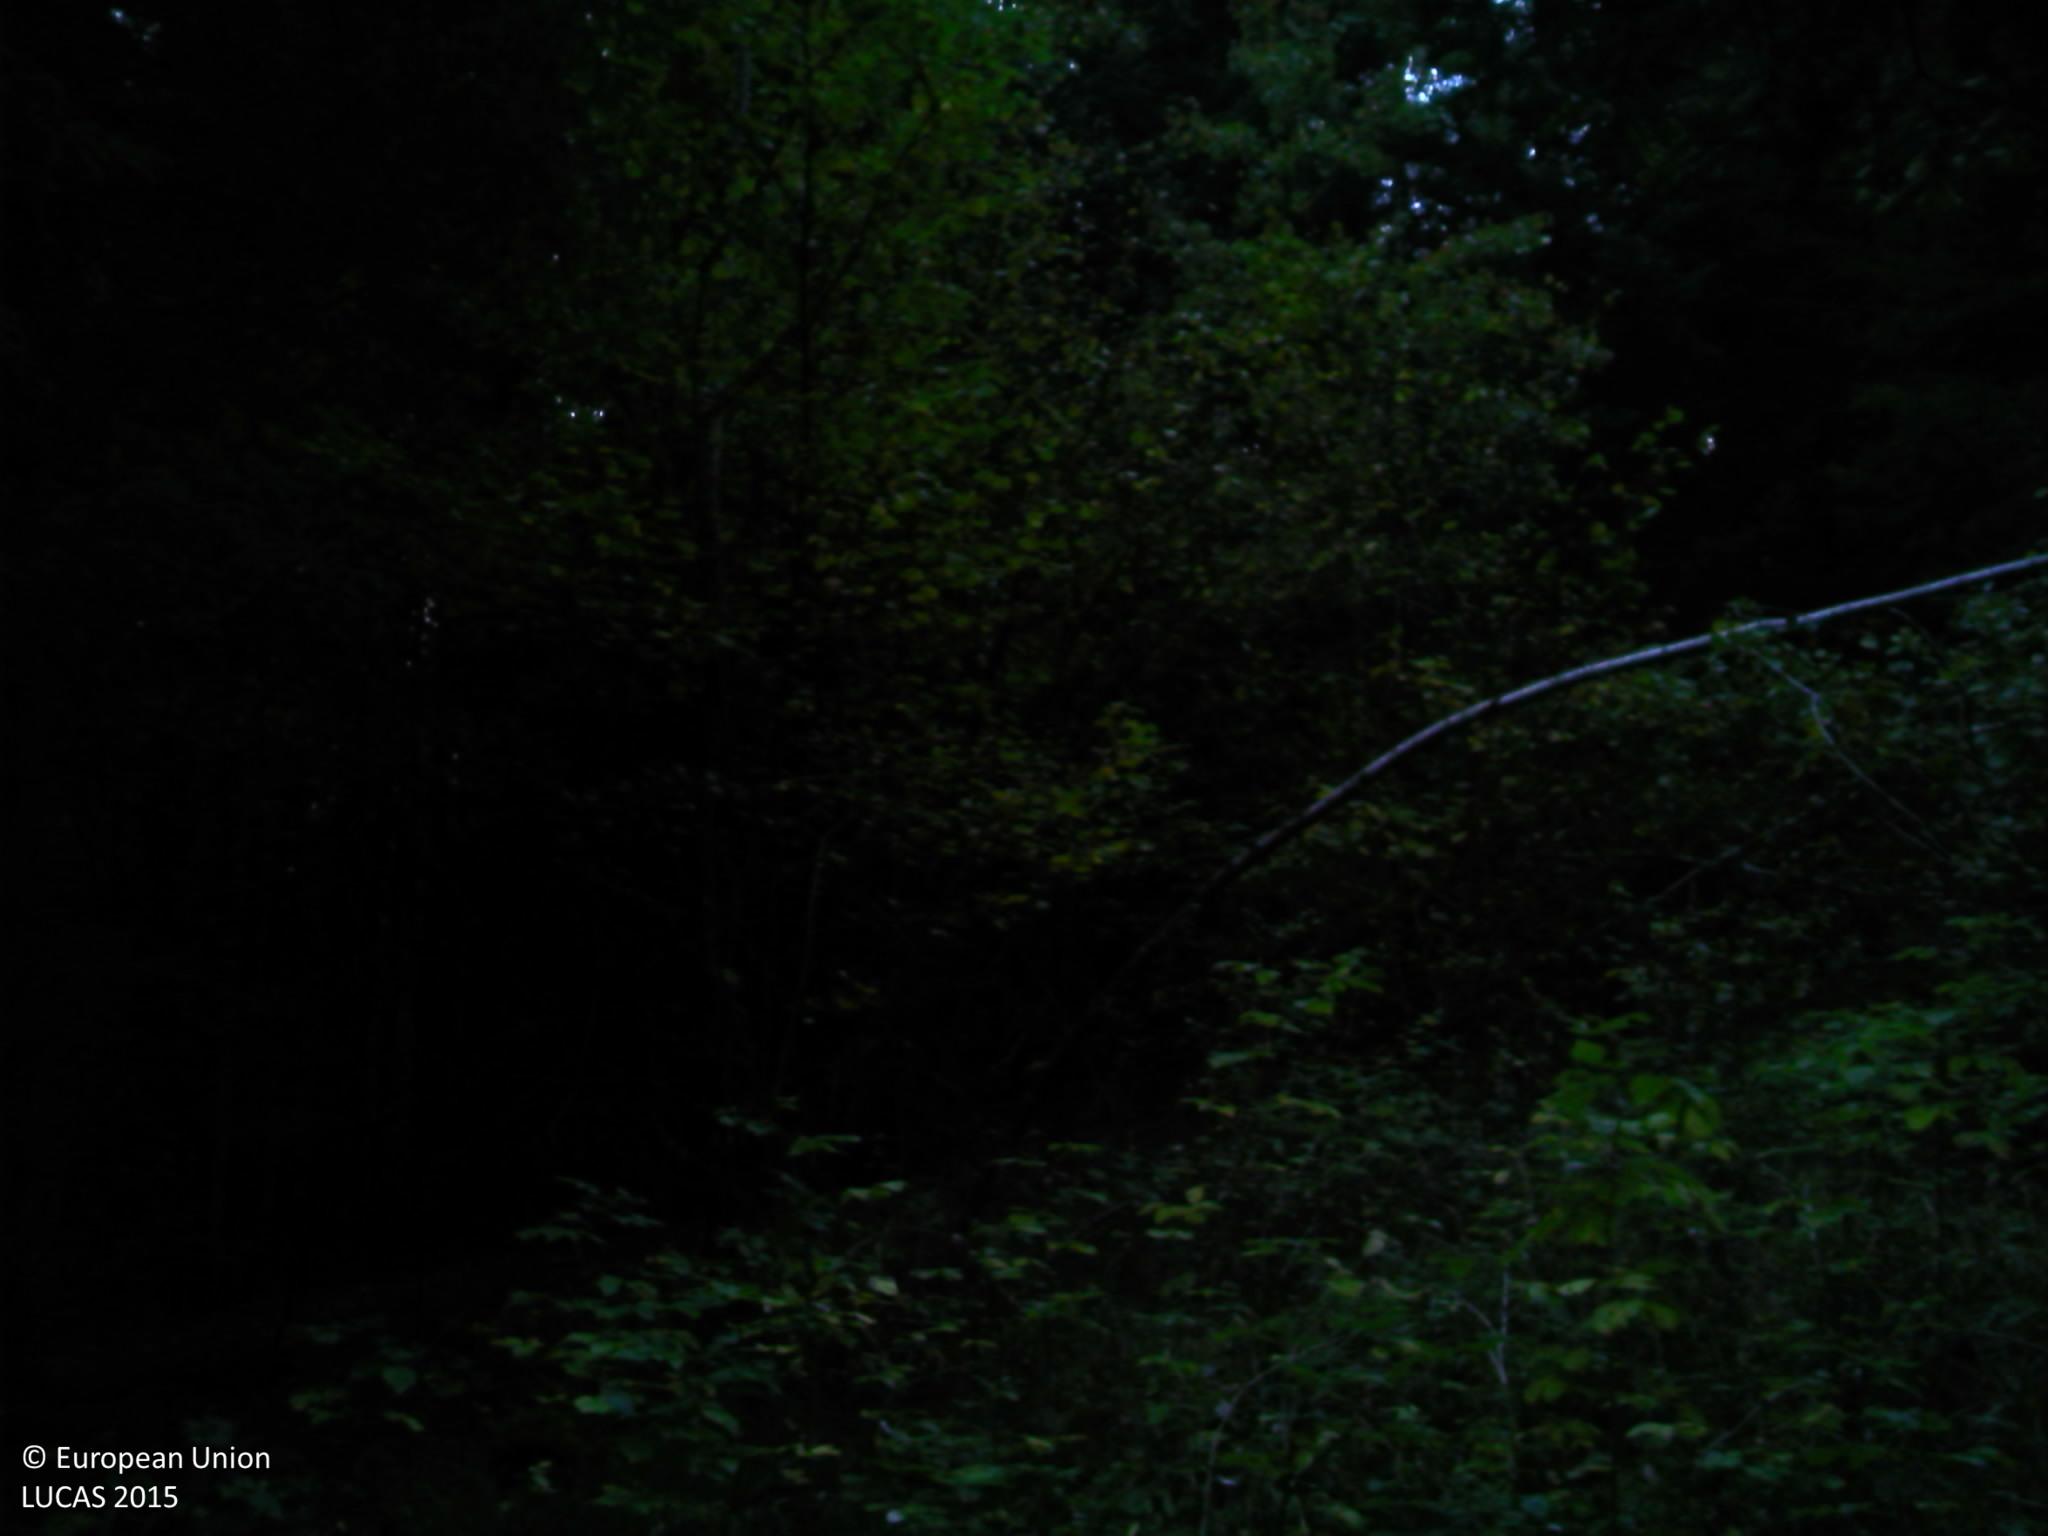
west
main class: Woodland
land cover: Spruce dominated mixed woodland
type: mountainous beech forest
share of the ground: > 75 %
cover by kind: coniferous forest trees 40 %, broadleaved forest trees 40 %, shrubs 20 %
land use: Forestry
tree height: > 5 m
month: October
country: FR
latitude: 46.8583
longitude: 6.1330
